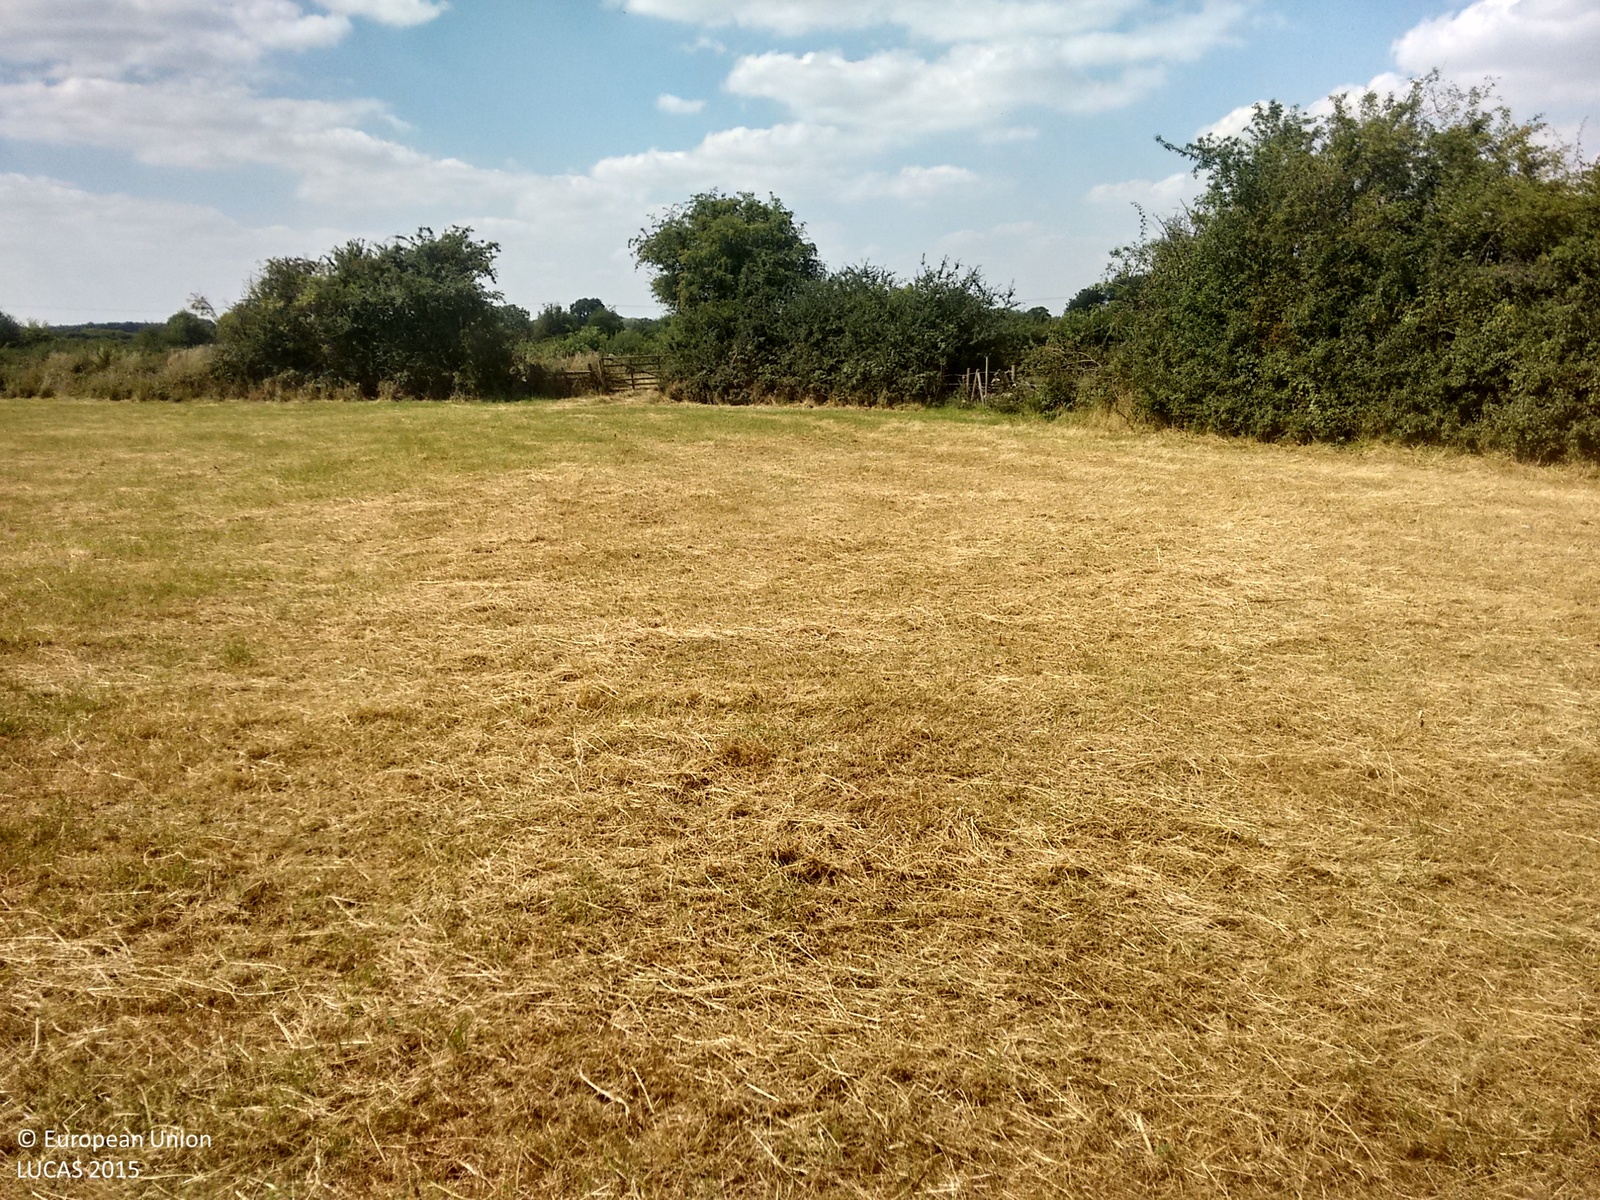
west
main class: Grassland
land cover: Grassland without tree/shrub cover
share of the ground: > 75 %
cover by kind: herbaceous plants 100 %
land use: Agriculture (excluding fallow land and kitchen gardens)
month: August
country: GB
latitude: 52.5685
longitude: -1.4250
